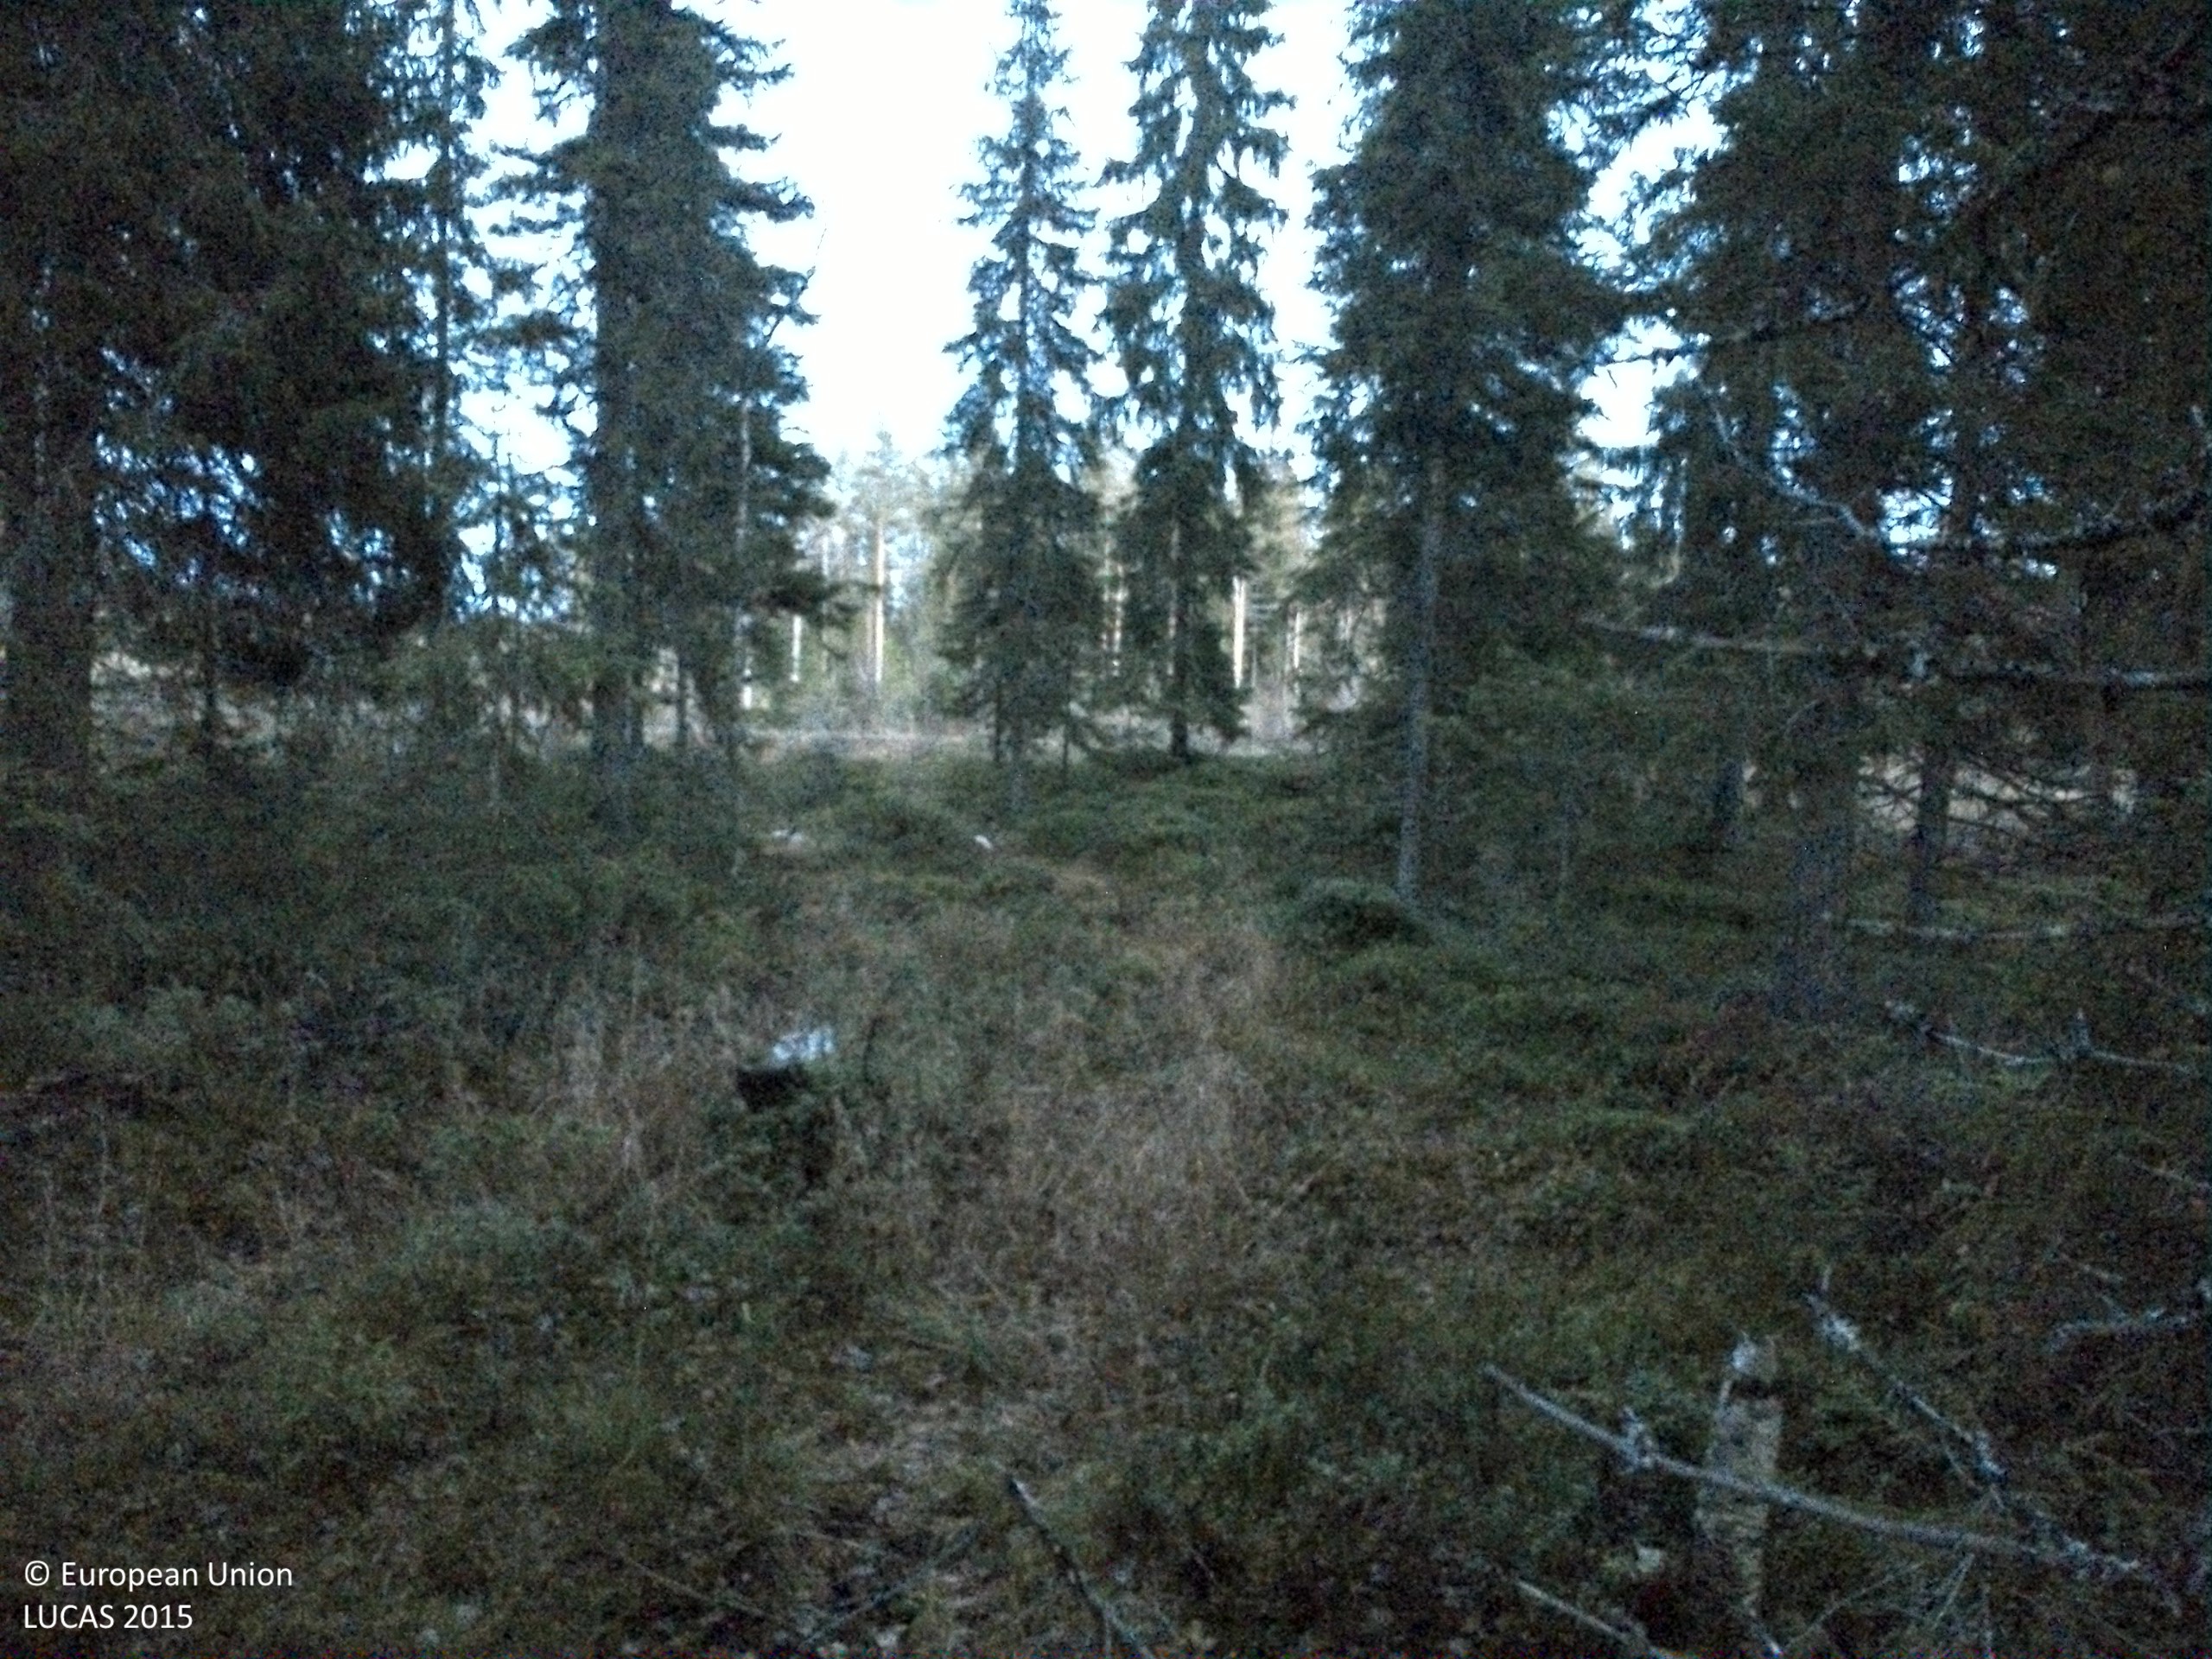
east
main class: Woodland
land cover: Other coniferous woodland
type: boreal forest
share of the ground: 50 - 75 %
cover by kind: coniferous forest trees 50 %, shrubs 30 %, lichens and mosses 15 %, broadleaved forest trees 5 %
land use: Forestry
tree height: > 5 m
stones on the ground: 10 - 25 %
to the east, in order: Other coniferous woodland; Paved roads, cycling and walking lanes; Grassland with sparse tree/shrub cover; Ditches and canals; Grassland with sparse tree/shrub cover; Shrubland with sparse tree cover; Grassland with sparse tree/shrub cover; Spruce dominated coniferous woodland; Ditches and canals; Other coniferous woodland
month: October
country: SE
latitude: 63.7789
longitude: 15.4713
